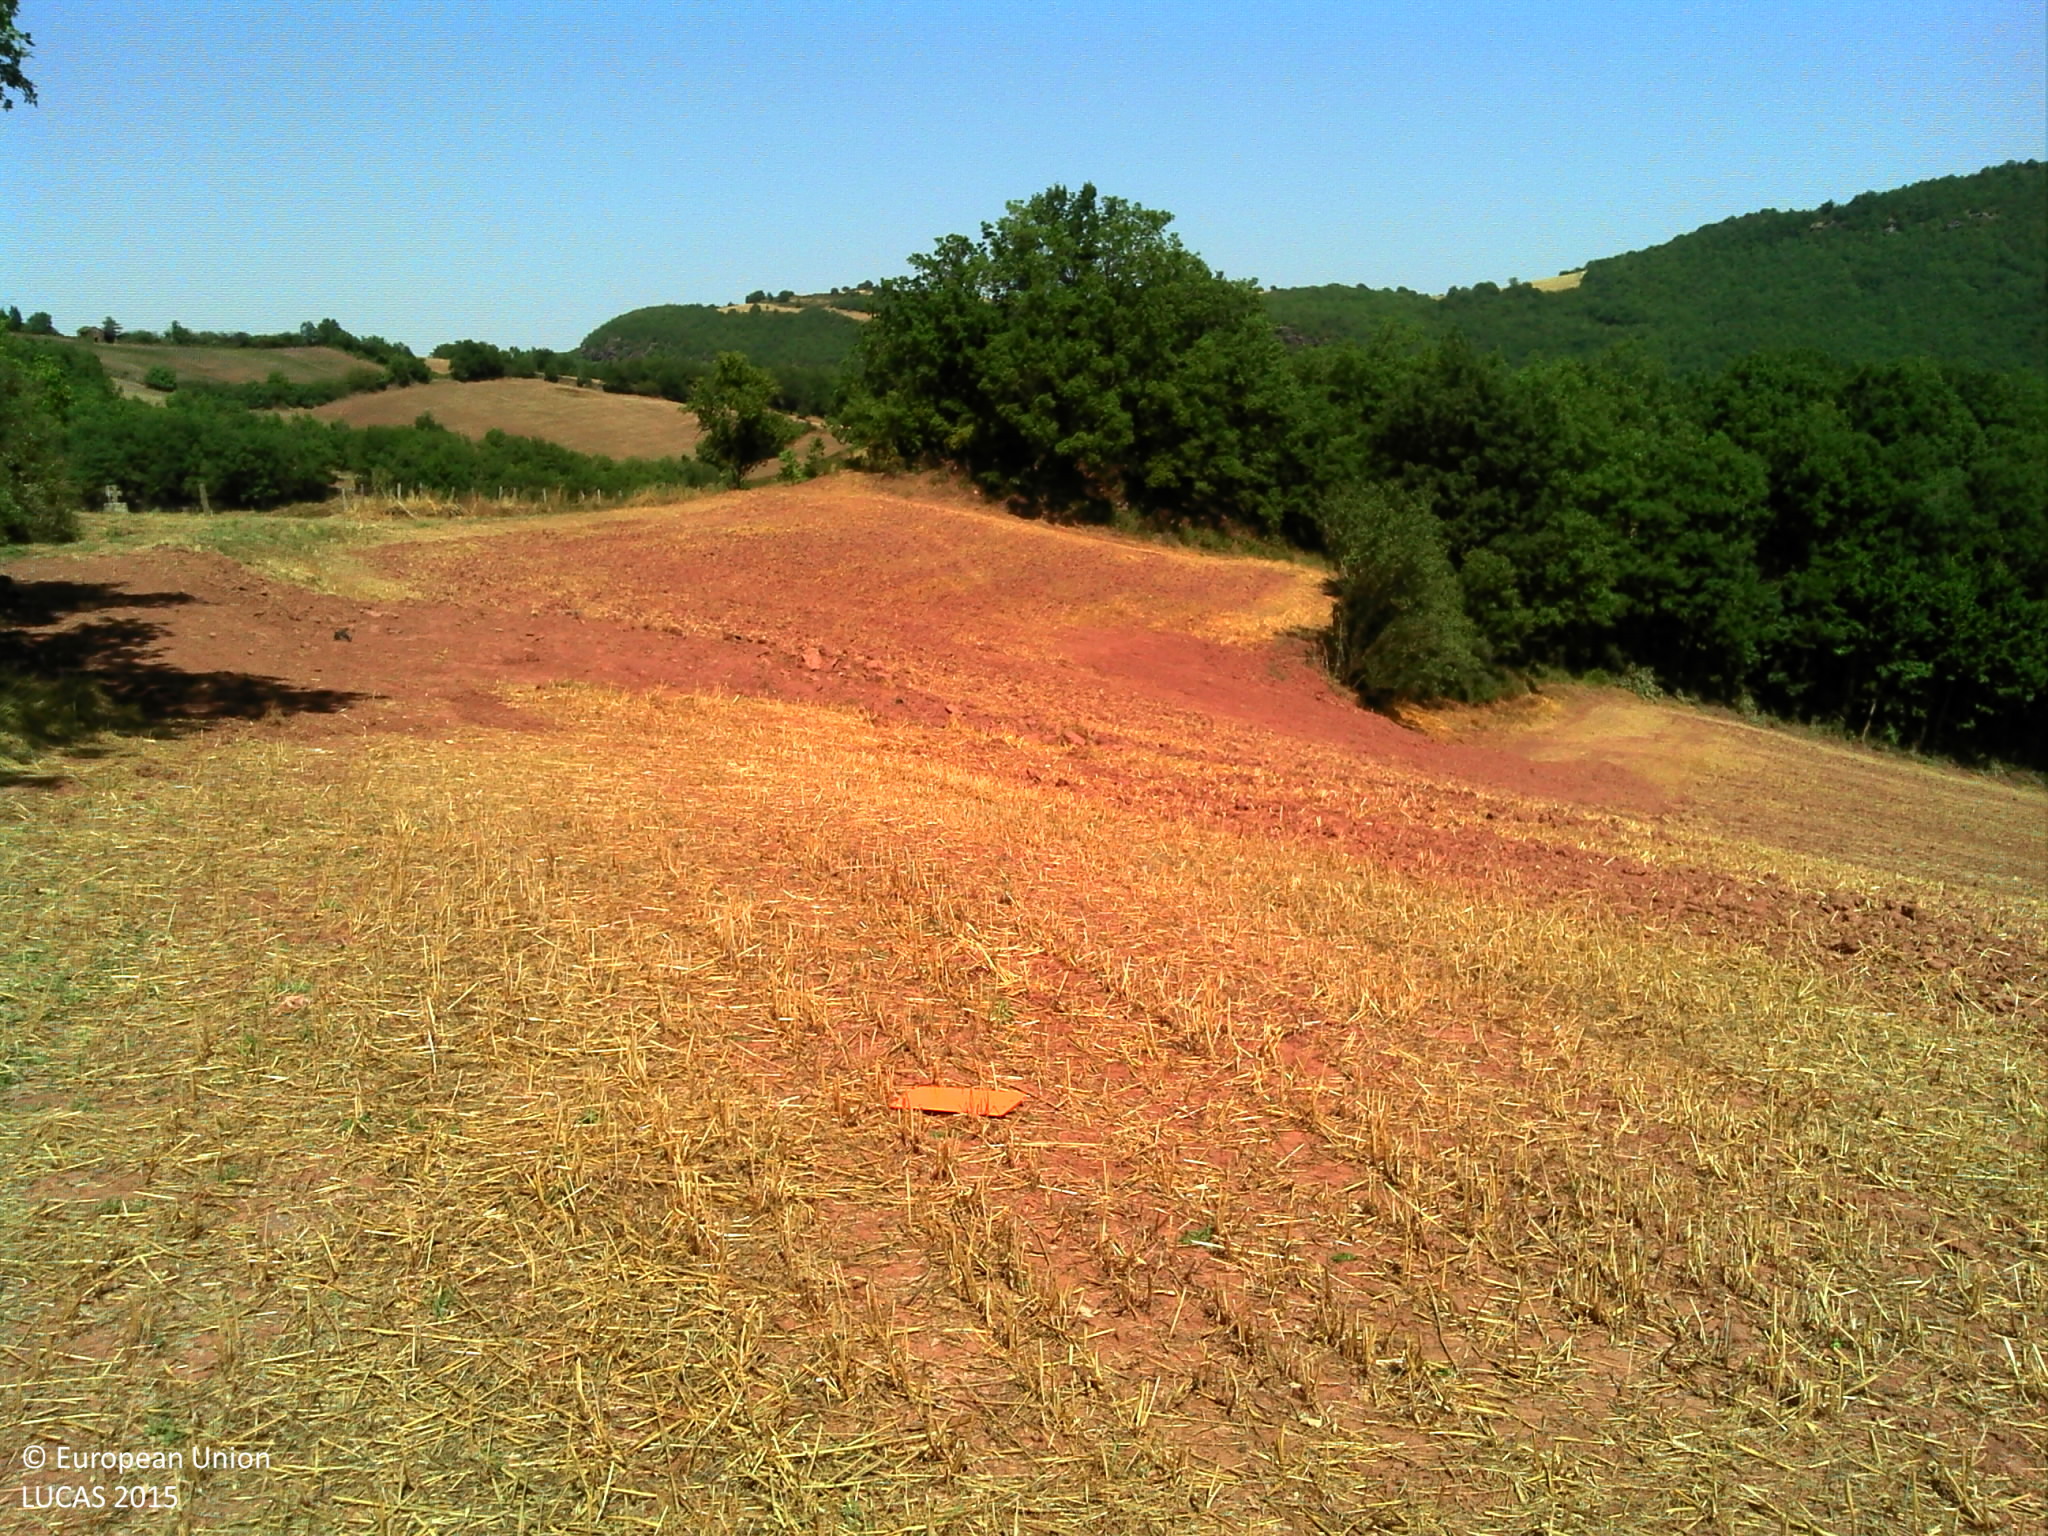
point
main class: Cropland
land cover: Barley
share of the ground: 25 - 50 %
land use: Agriculture (excluding fallow land and kitchen gardens)
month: August
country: FR
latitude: 43.8169
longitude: 2.6334
